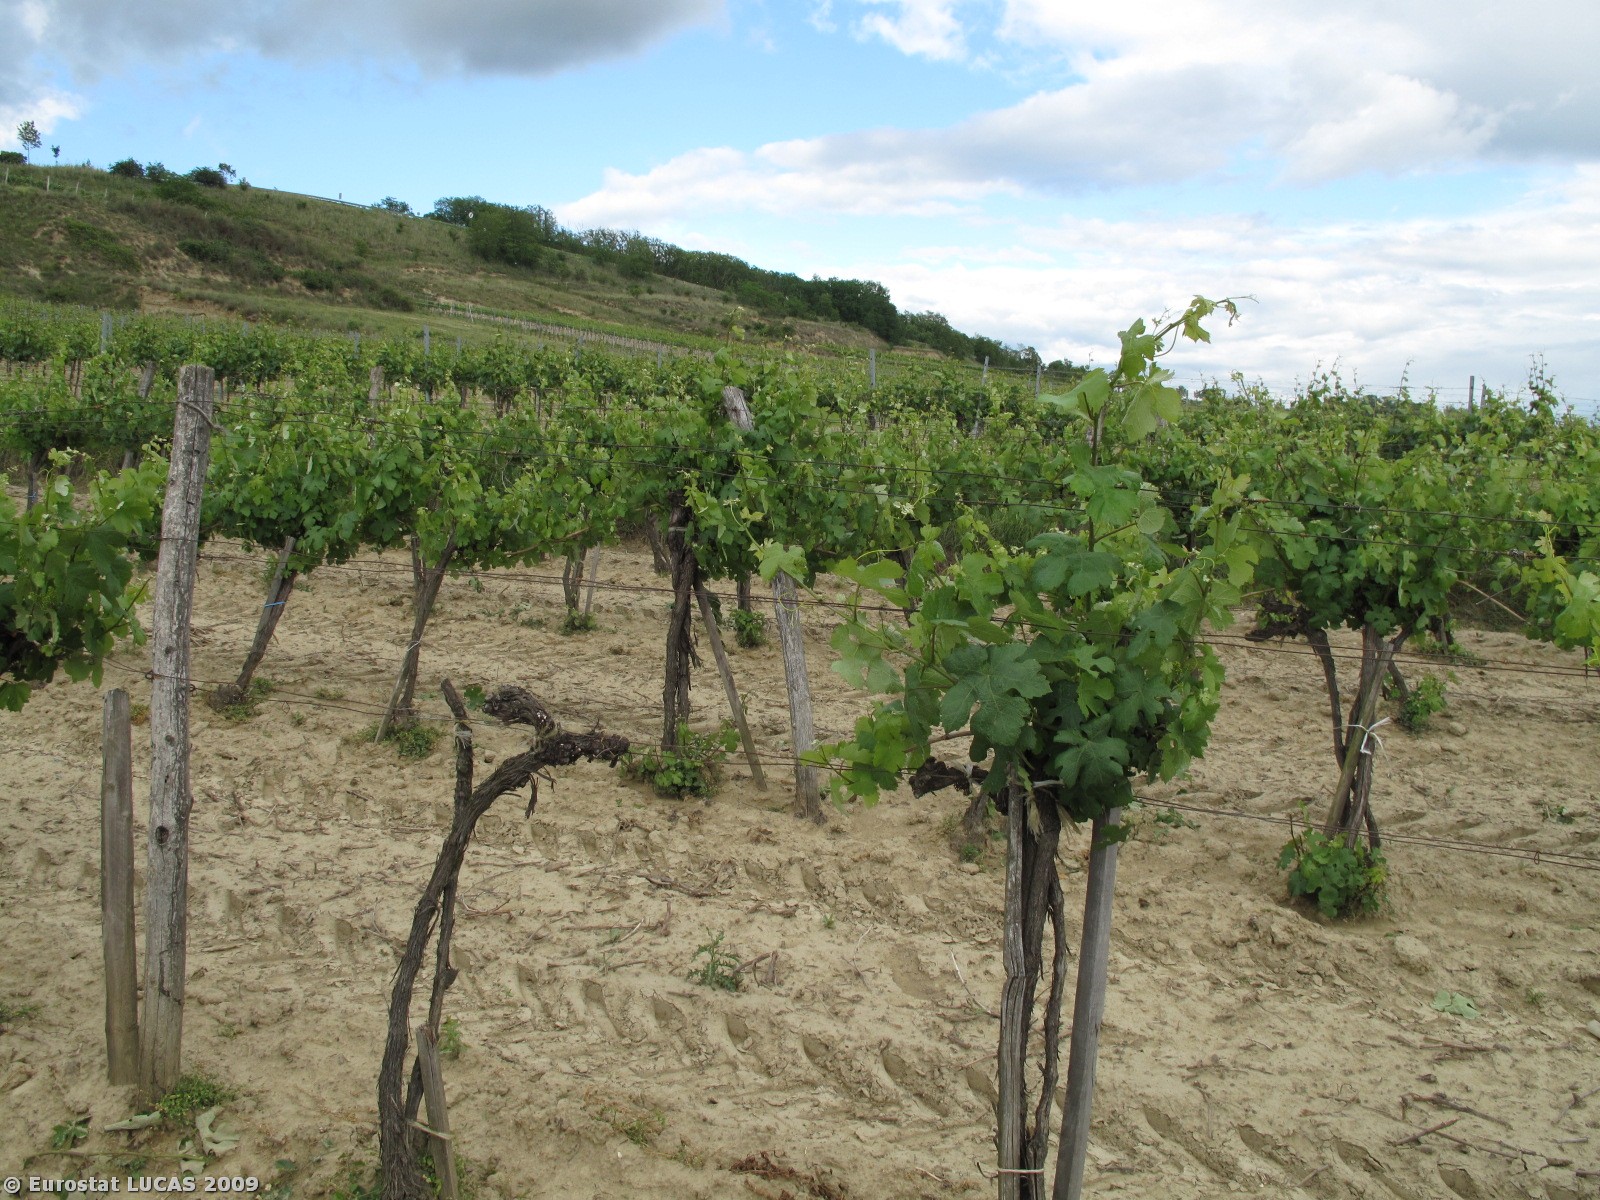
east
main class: Cropland
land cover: Vineyards
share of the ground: 10 - 25 %
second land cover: Bare land
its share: > 75 %
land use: Agriculture (excluding fallow land and kitchen gardens)
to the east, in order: Vineyards; Bare land; Grassland without tree/shrub cover; Vineyards; Bare land; Grass margins; Vineyards; Bare land; Grassland with sparse tree/shrub cover
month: May
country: AT
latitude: 48.7247
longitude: 16.0540
